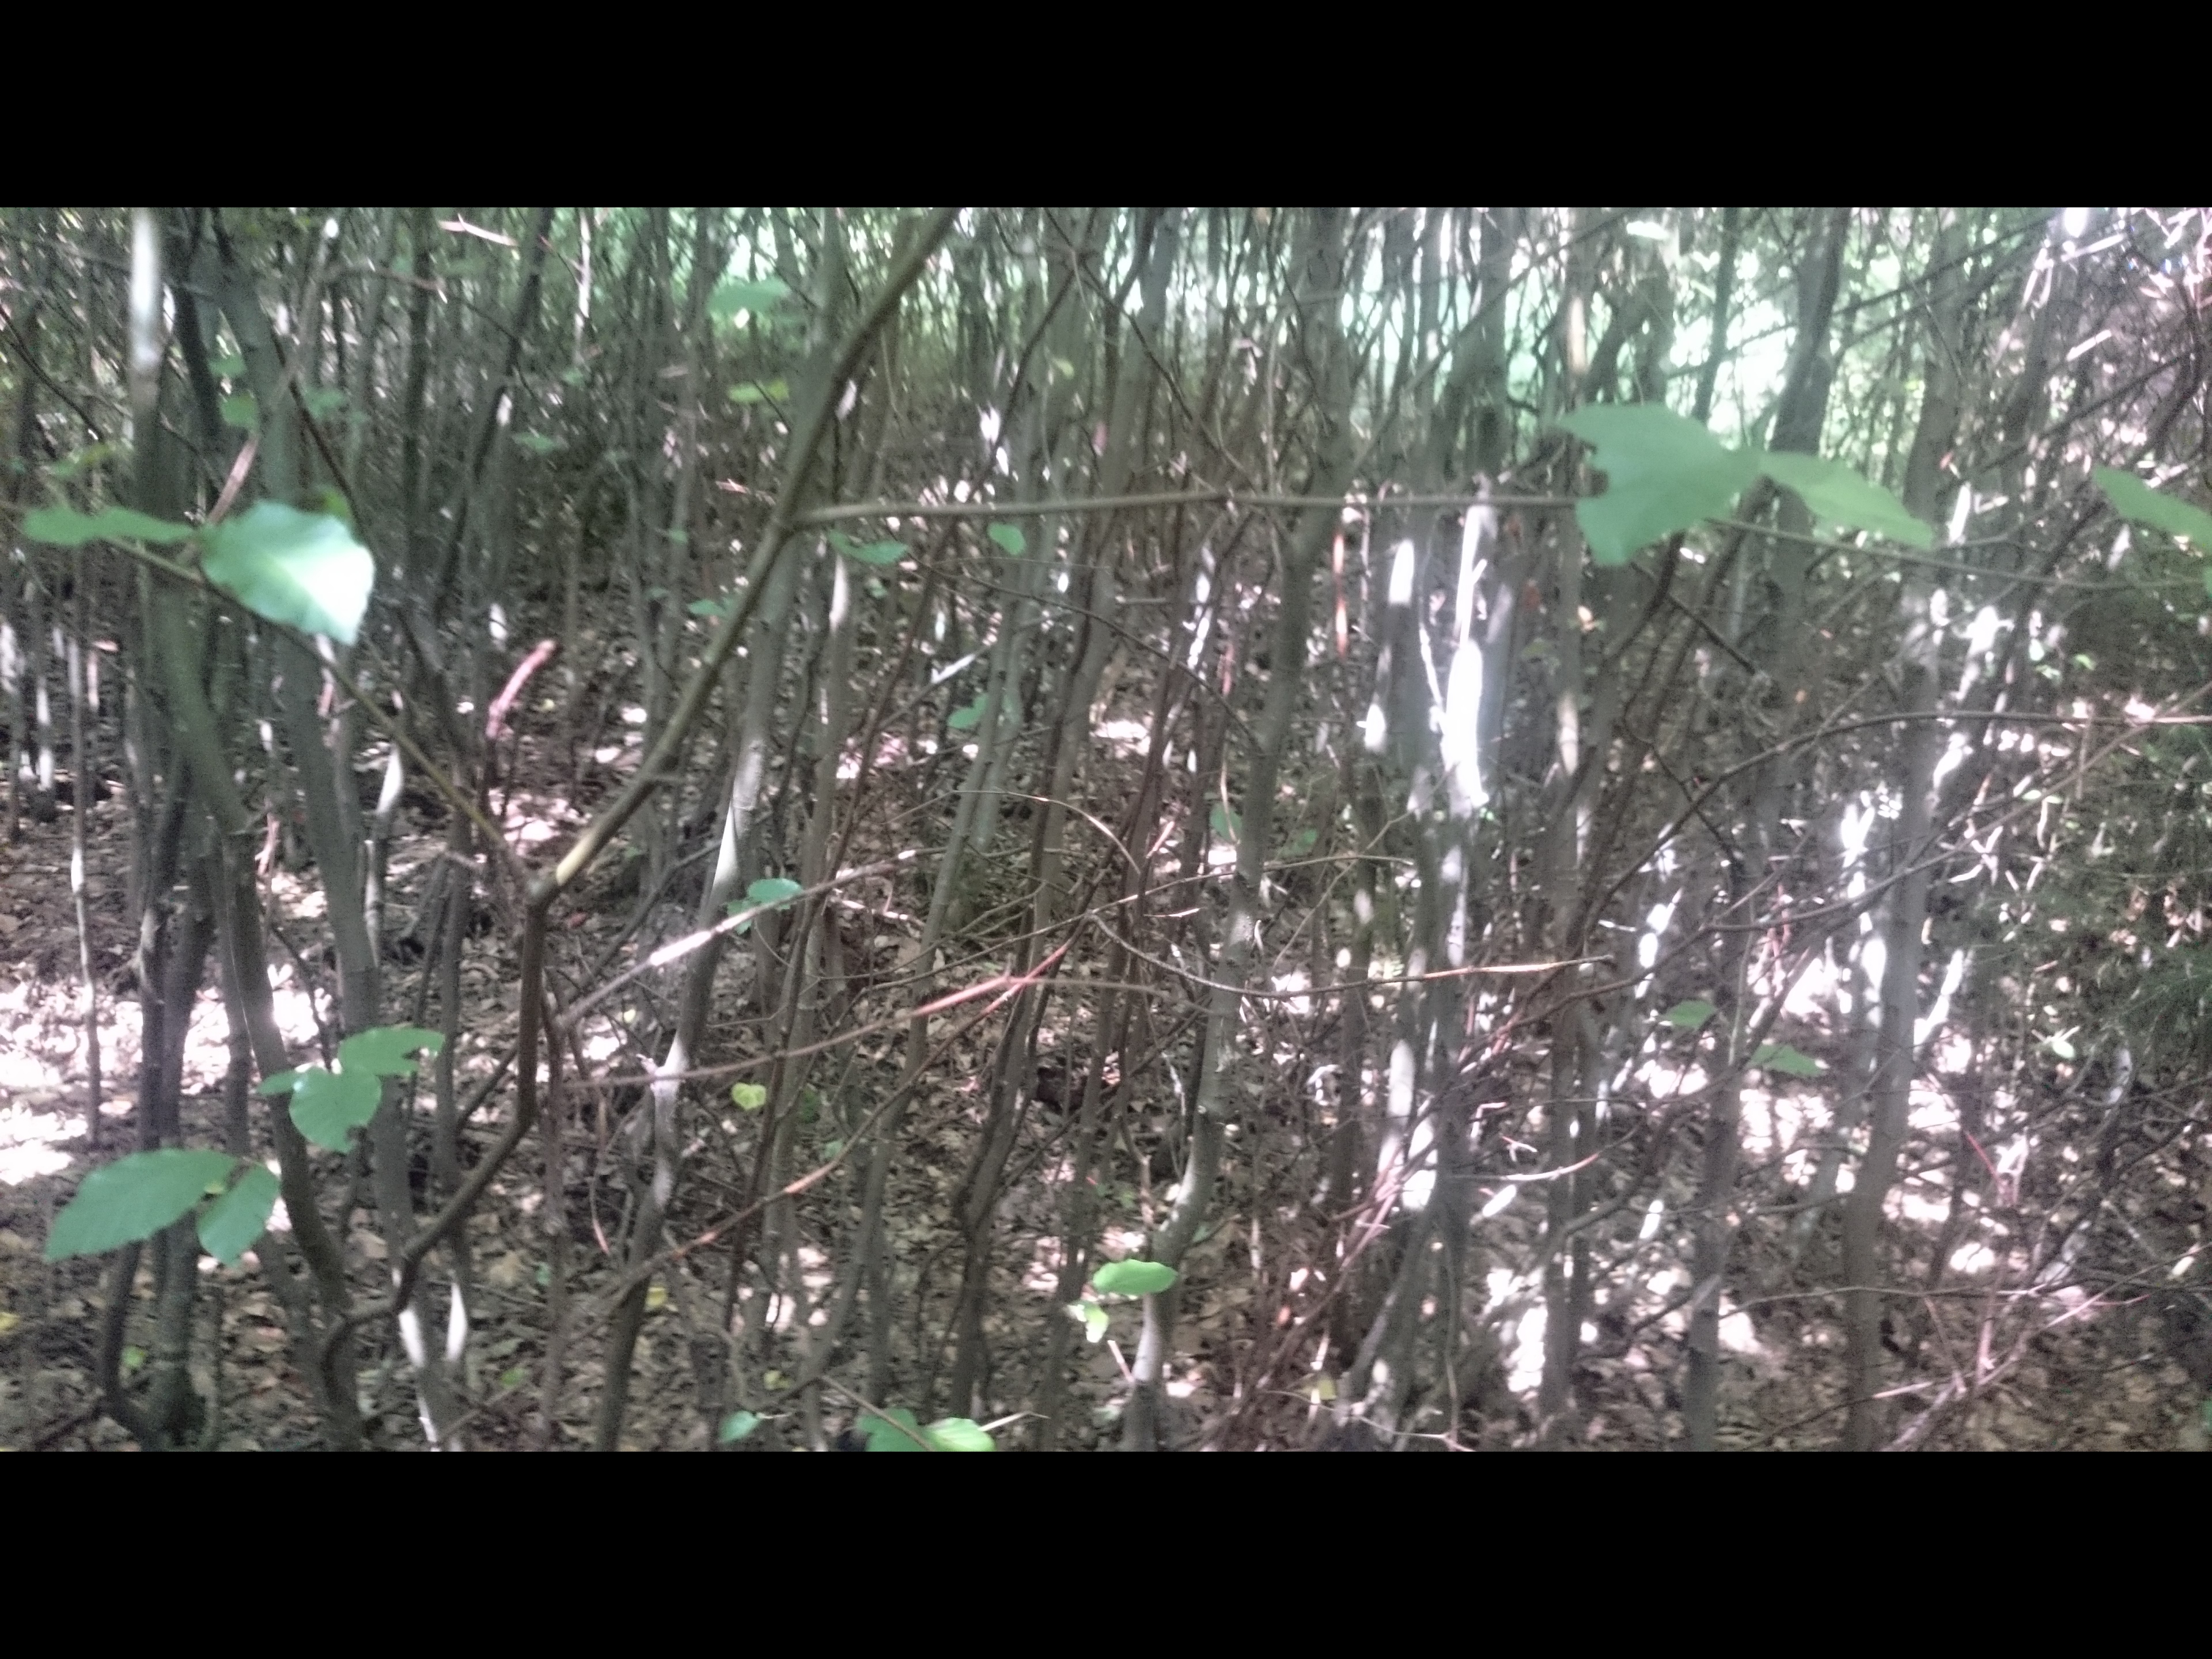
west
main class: Woodland
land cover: Broadleaved woodland
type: beech forest
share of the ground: > 75 %
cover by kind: broadleaved forest trees 90 %, shrubs 10 %
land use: Forestry
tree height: > 5 m
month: July
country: AT
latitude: 47.1208
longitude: 15.6814
